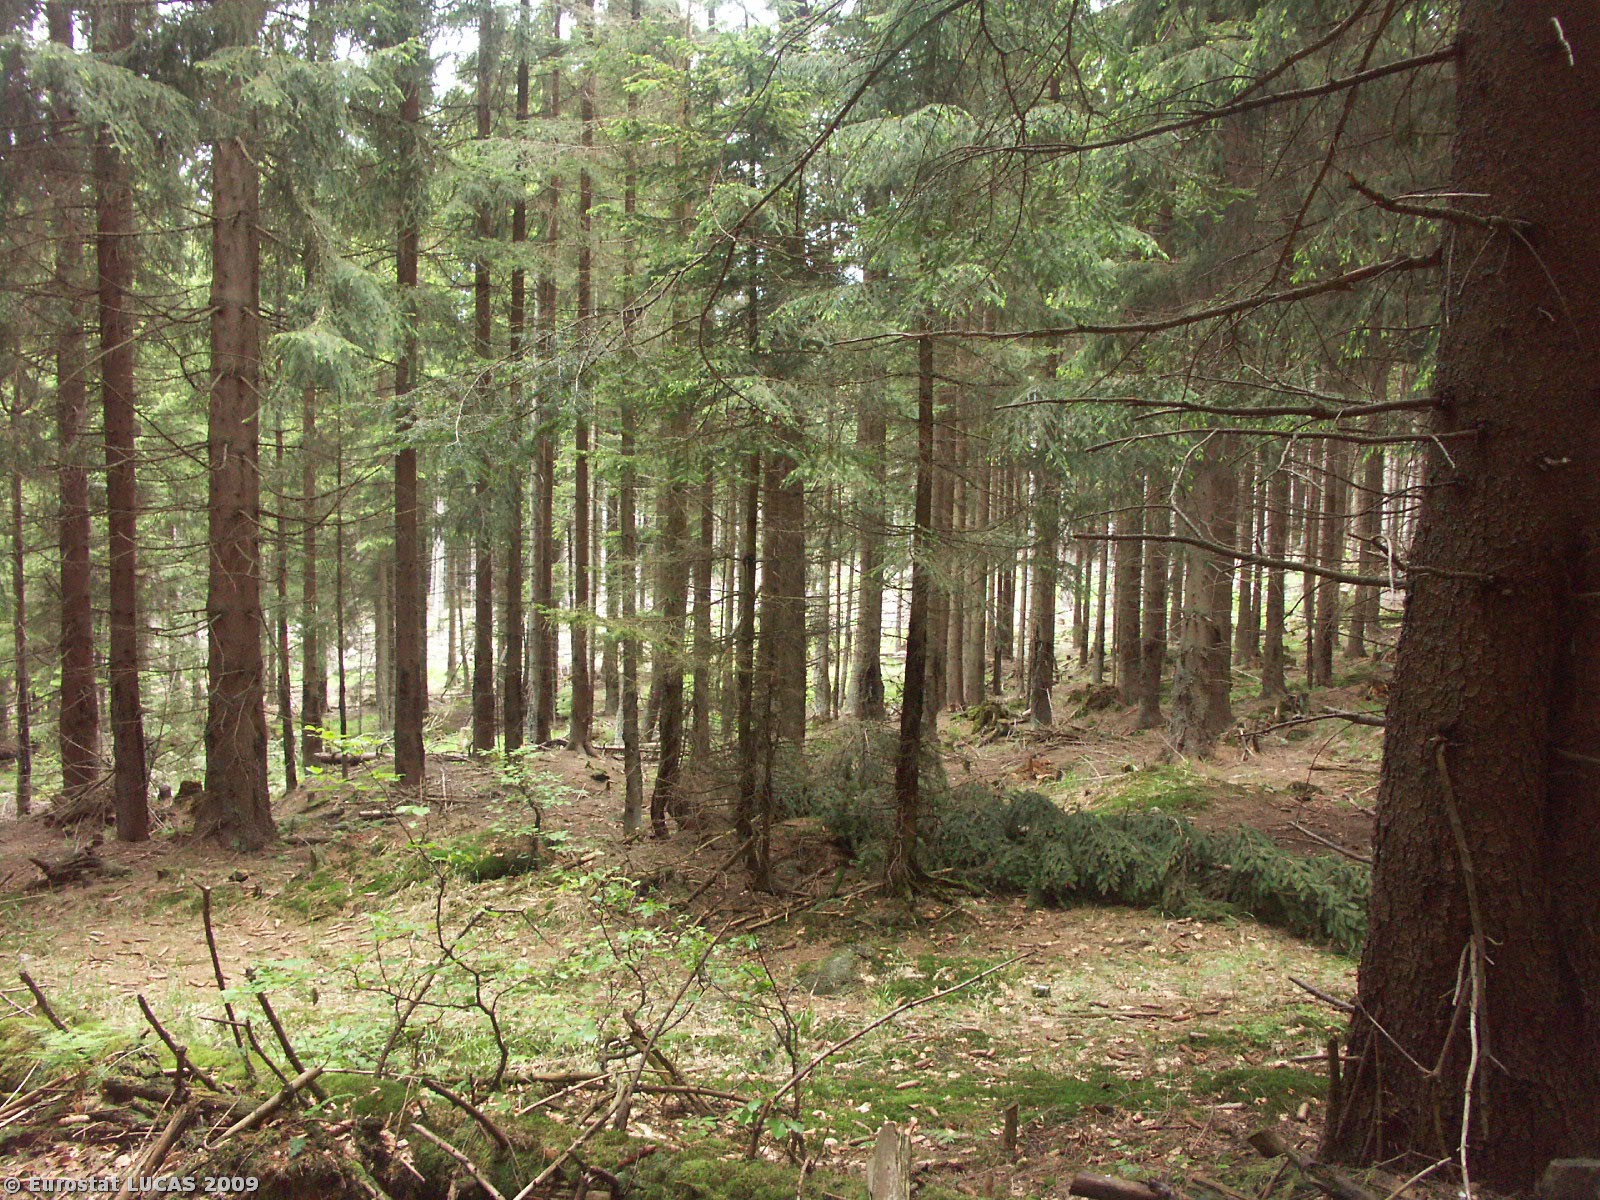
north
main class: Woodland
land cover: Mixed woodland
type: mountainous beech forest
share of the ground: > 75 %
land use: Forestry
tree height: > 5 m
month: May
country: CZ
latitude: 48.6120
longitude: 14.6534
